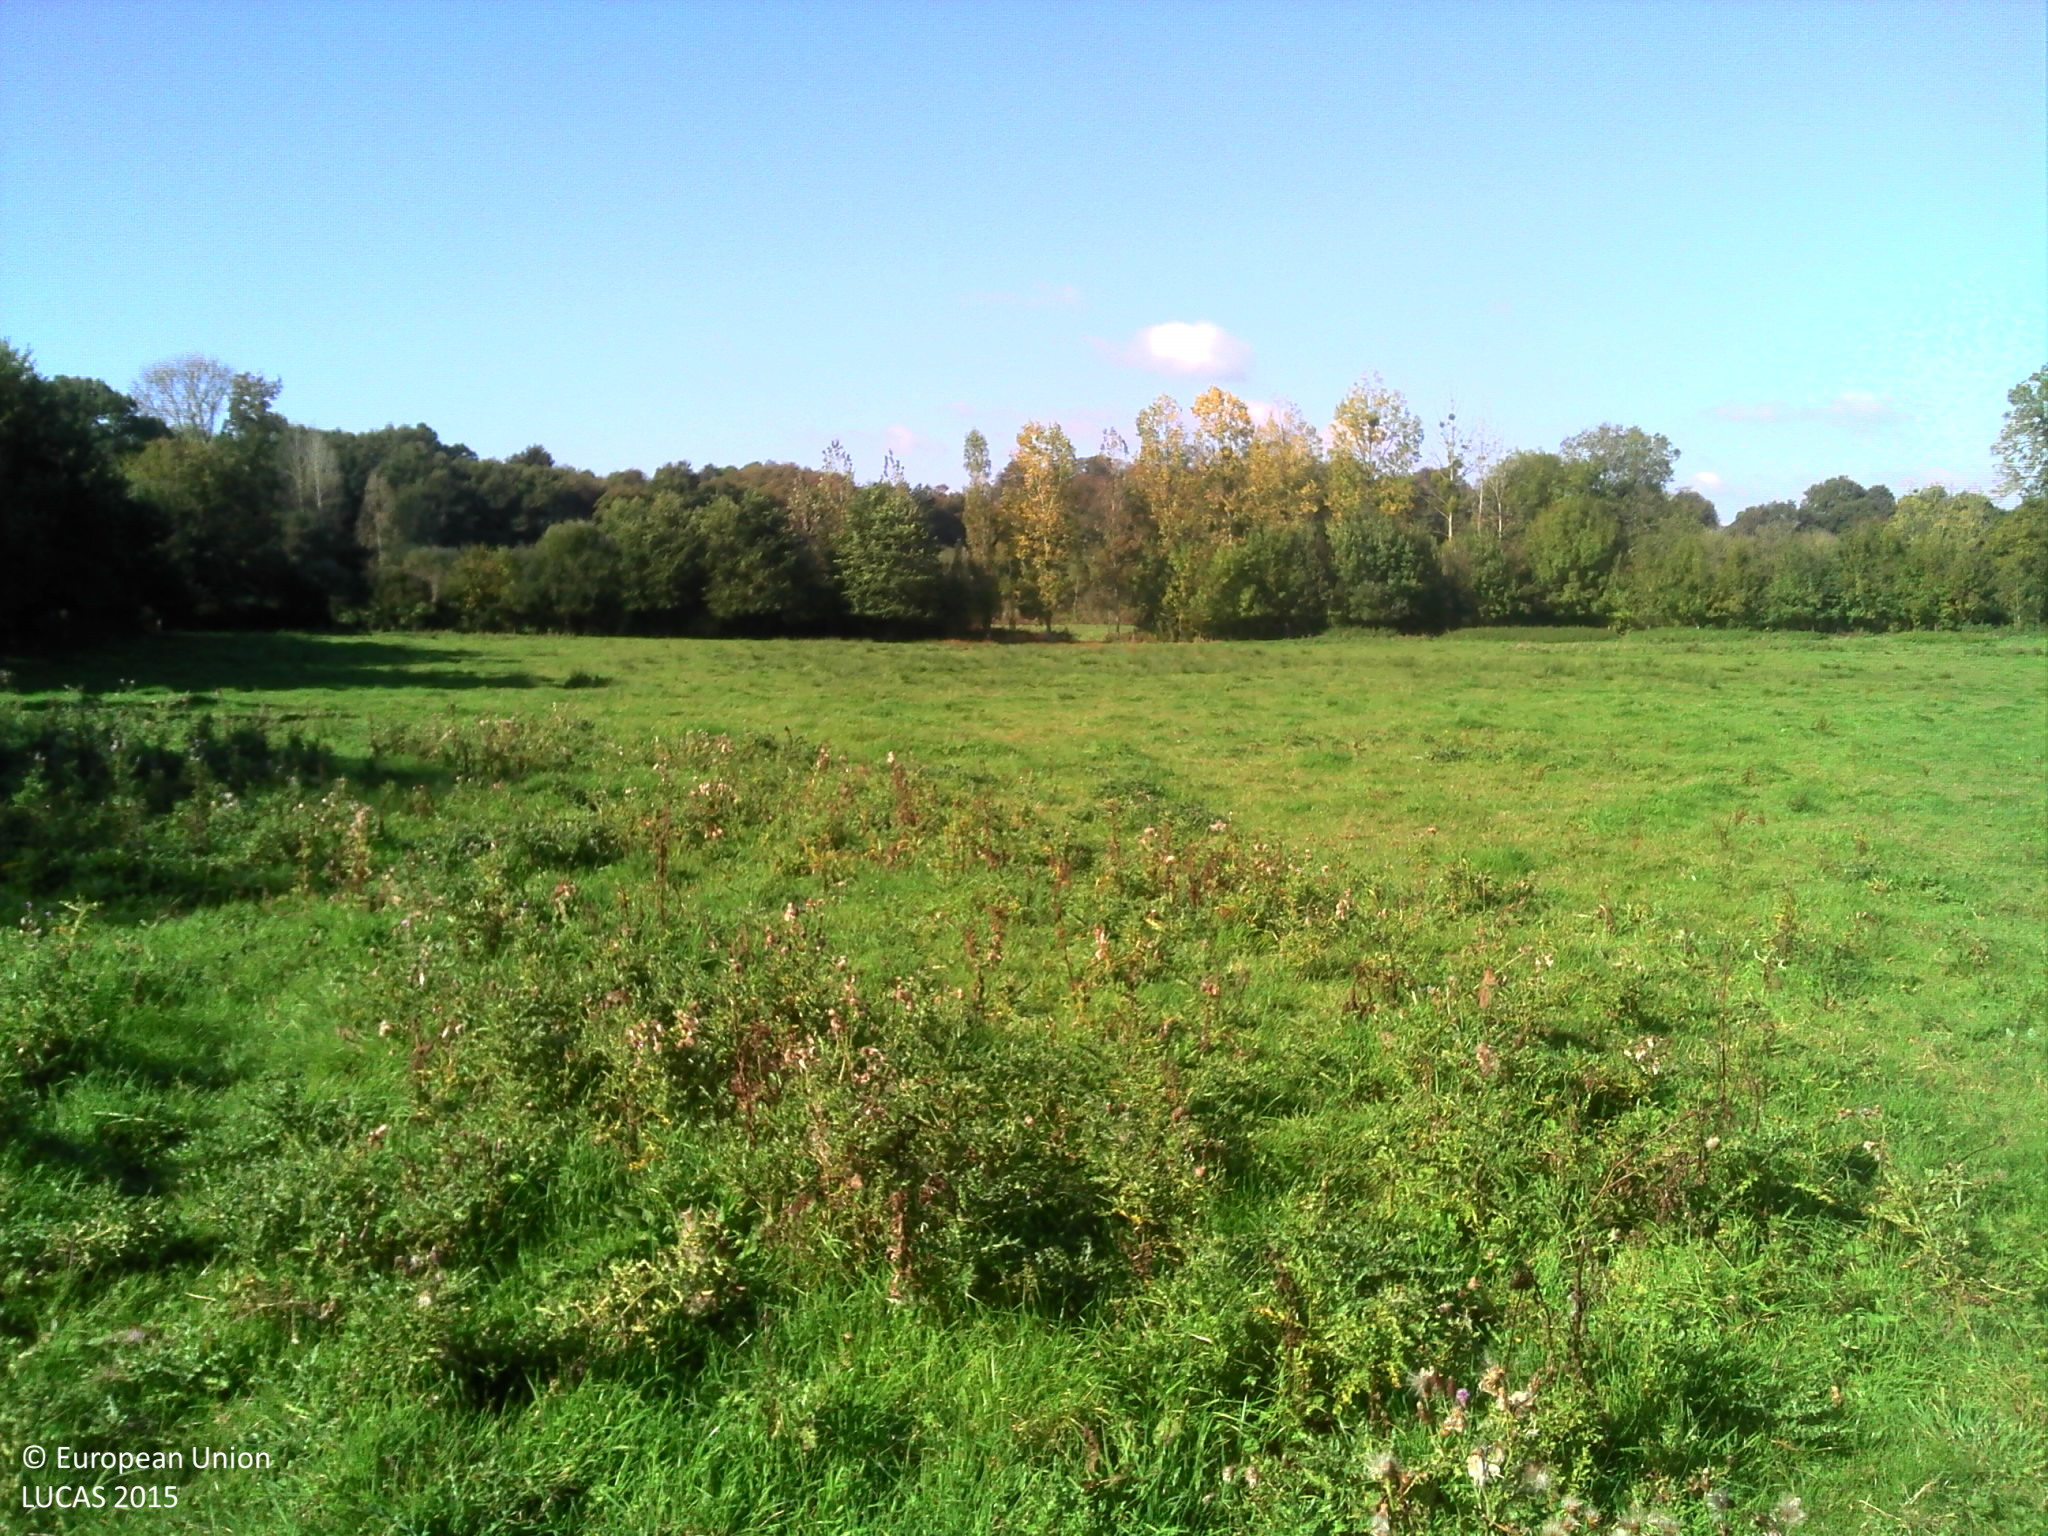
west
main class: Grassland
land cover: Grassland without tree/shrub cover
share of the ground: > 75 %
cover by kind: herbaceous plants 100 %
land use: Agriculture (excluding fallow land and kitchen gardens)
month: October
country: FR
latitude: 46.8421
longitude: -1.4602
